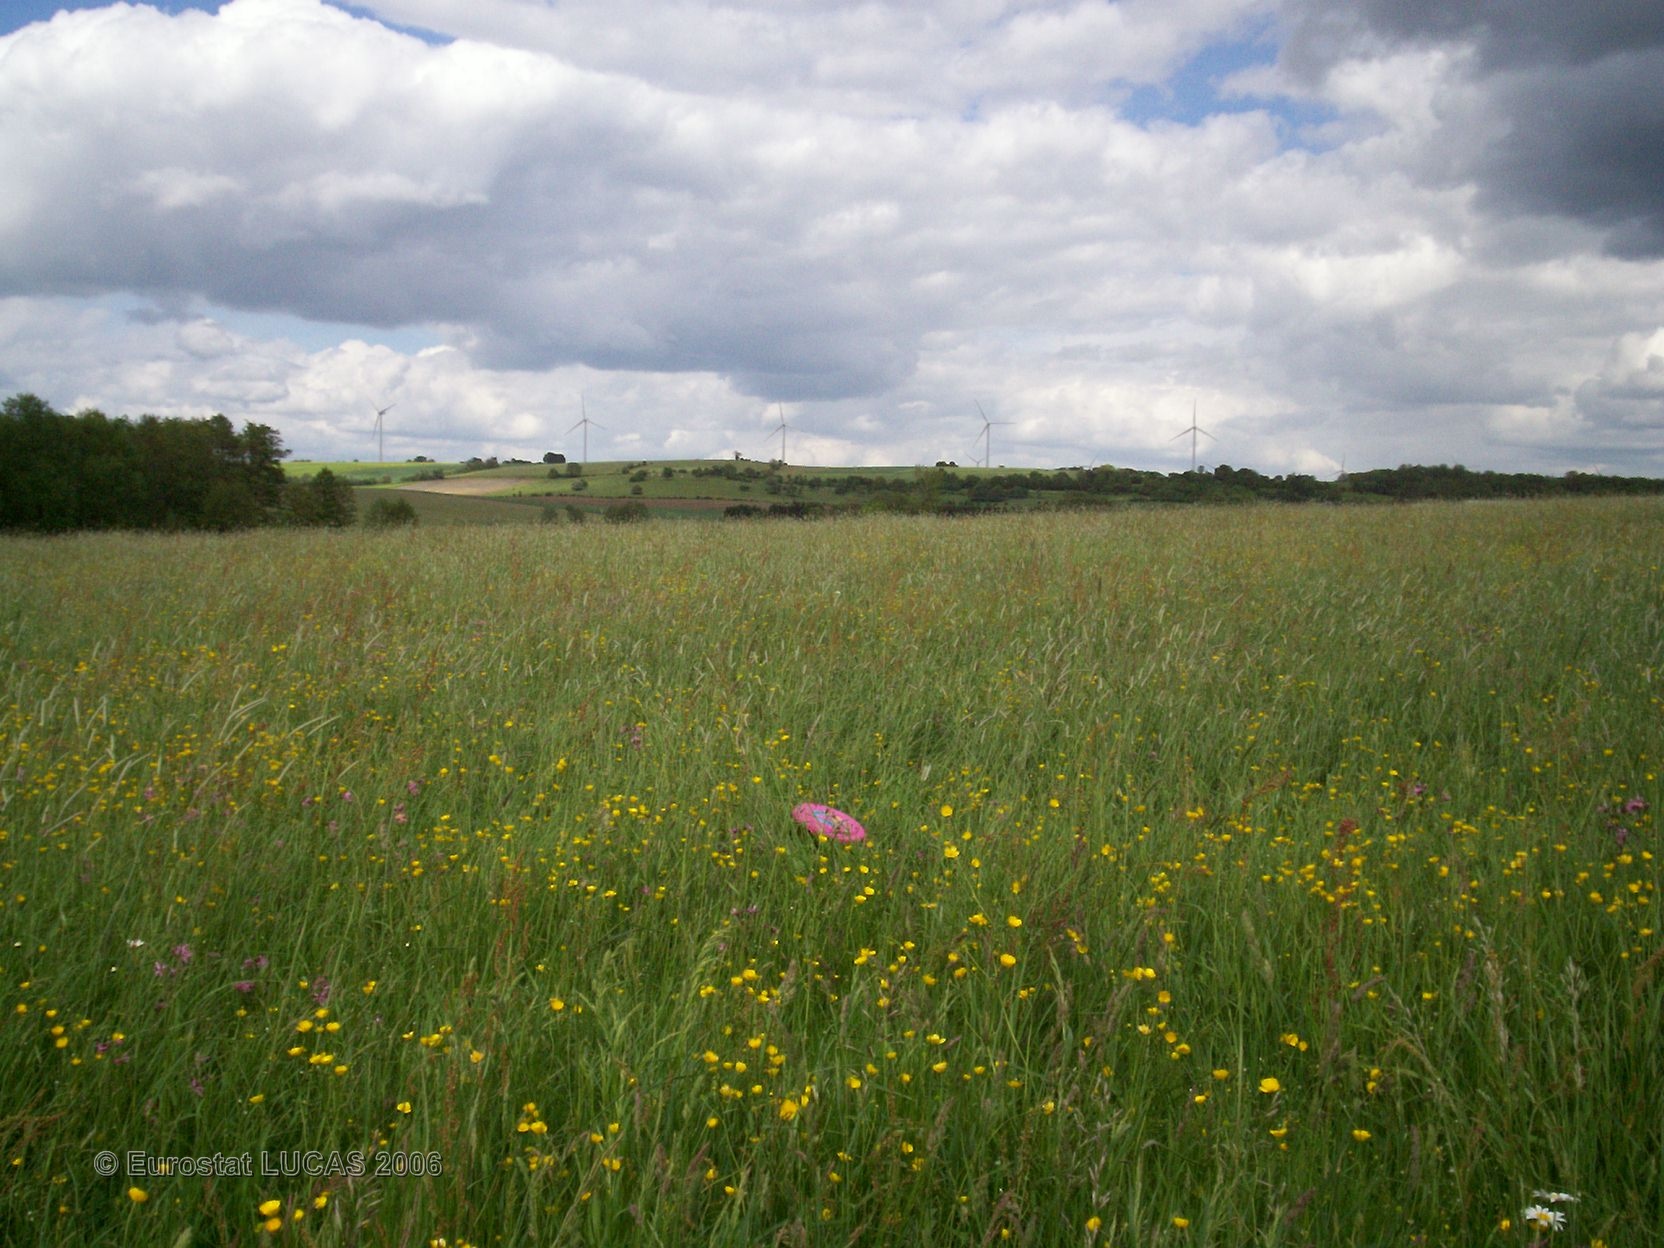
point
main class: Grassland
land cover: Grassland without tree/shrub cover
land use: Agriculture (excluding fallow land and kitchen gardens)
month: May
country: FR
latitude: 48.6089
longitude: 6.7862
